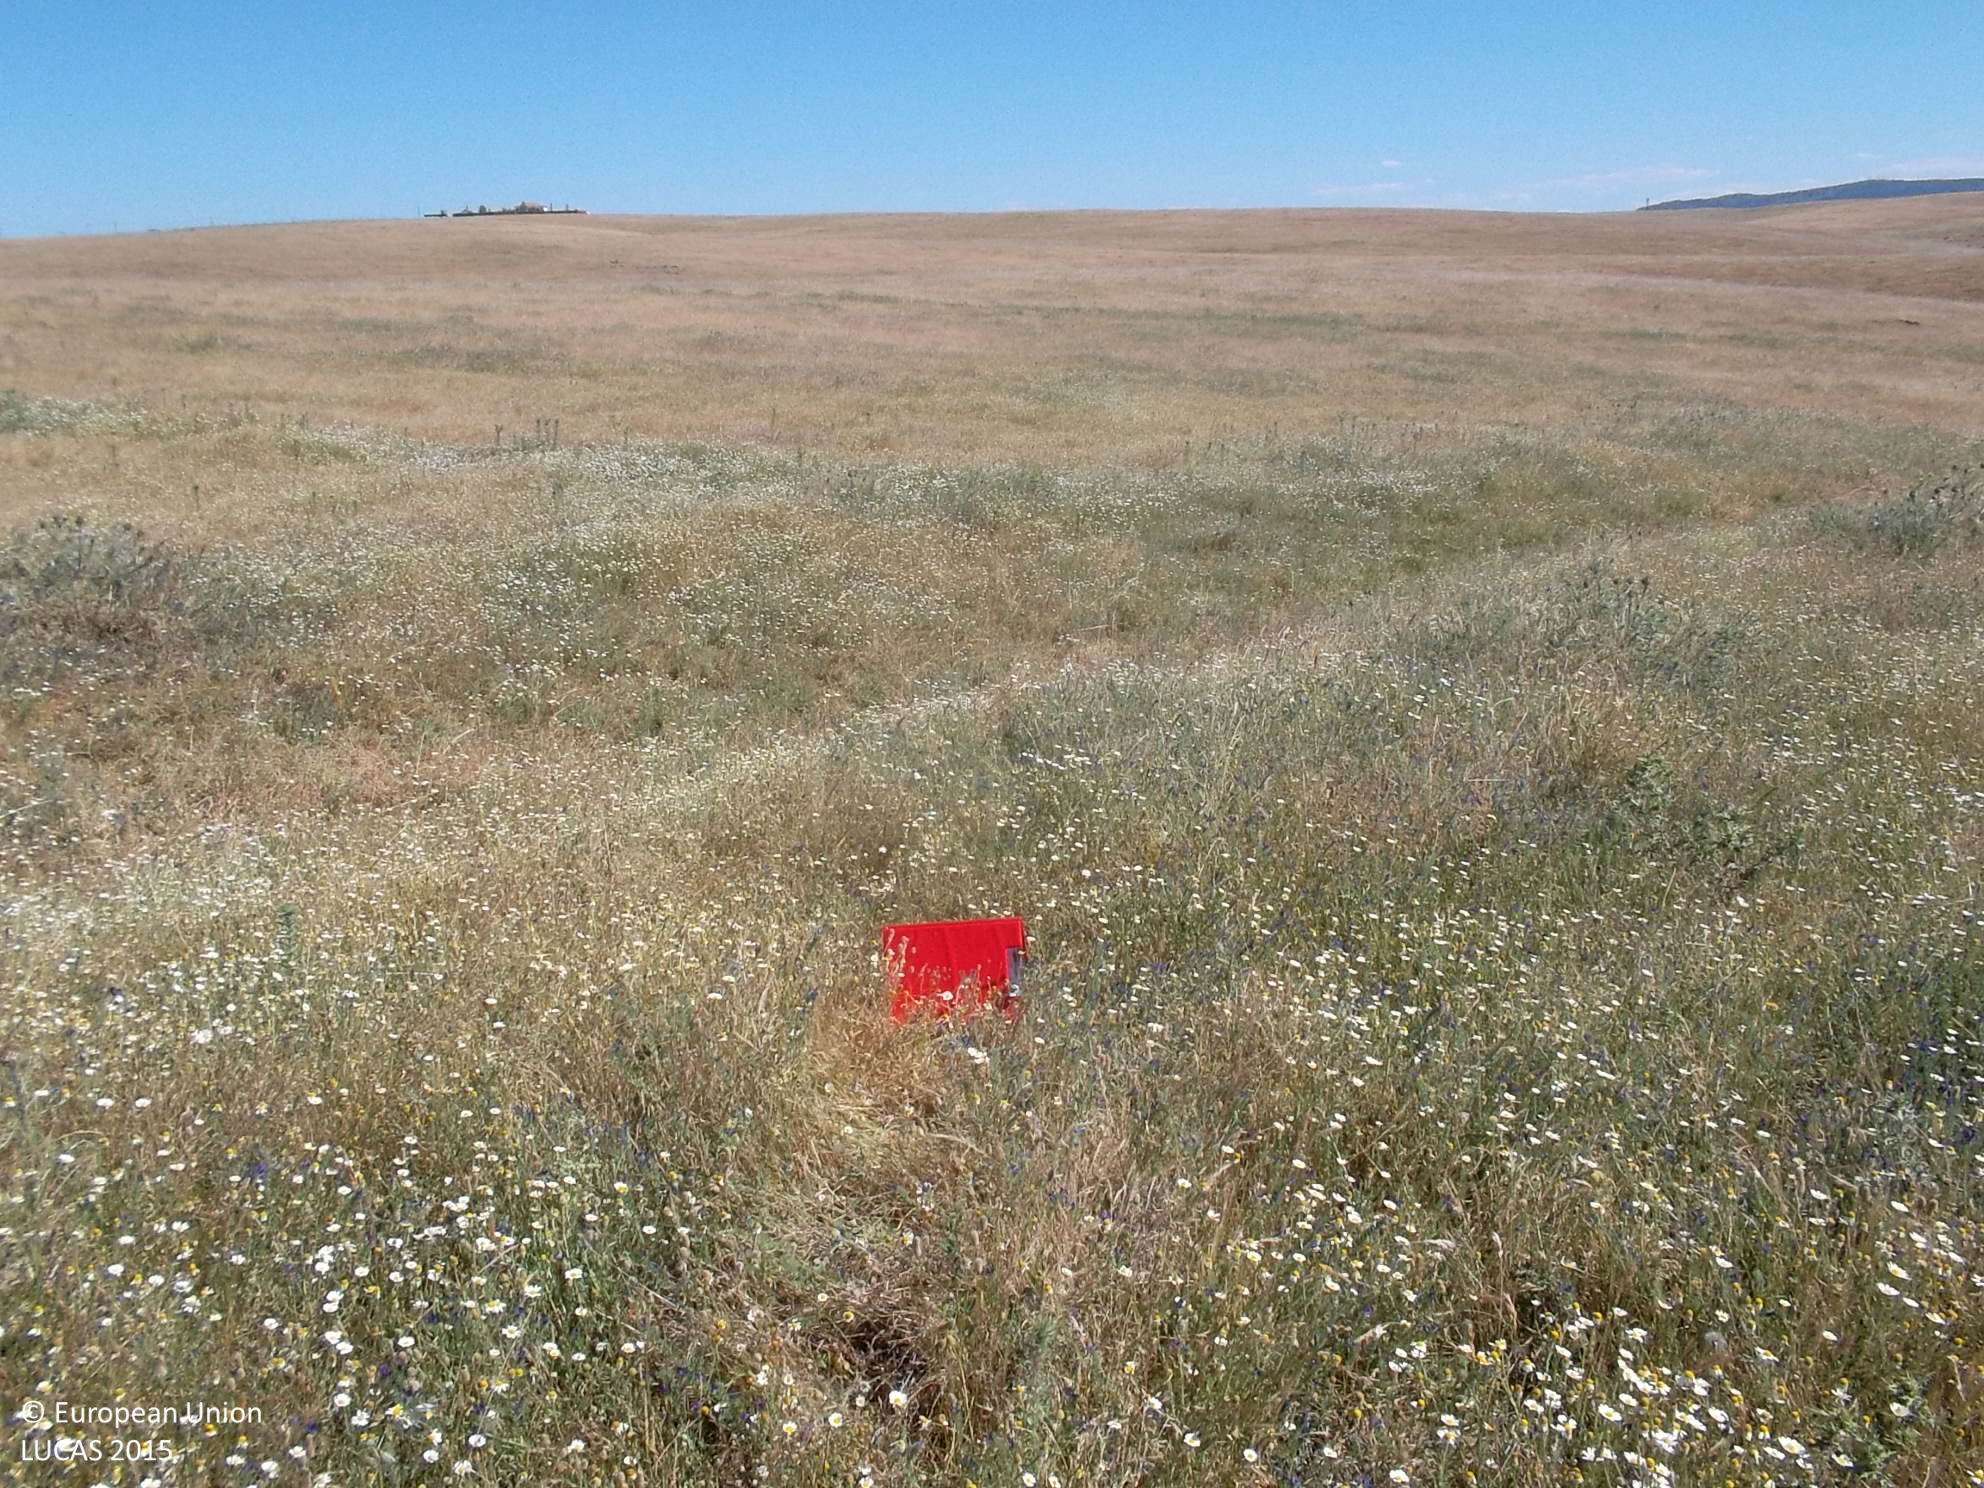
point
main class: Grassland
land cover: Grassland without tree/shrub cover
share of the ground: > 75 %
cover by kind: herbaceous plants 100 %
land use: Agriculture (excluding fallow land and kitchen gardens)
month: May
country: ES
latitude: 38.6311
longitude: -4.3917
